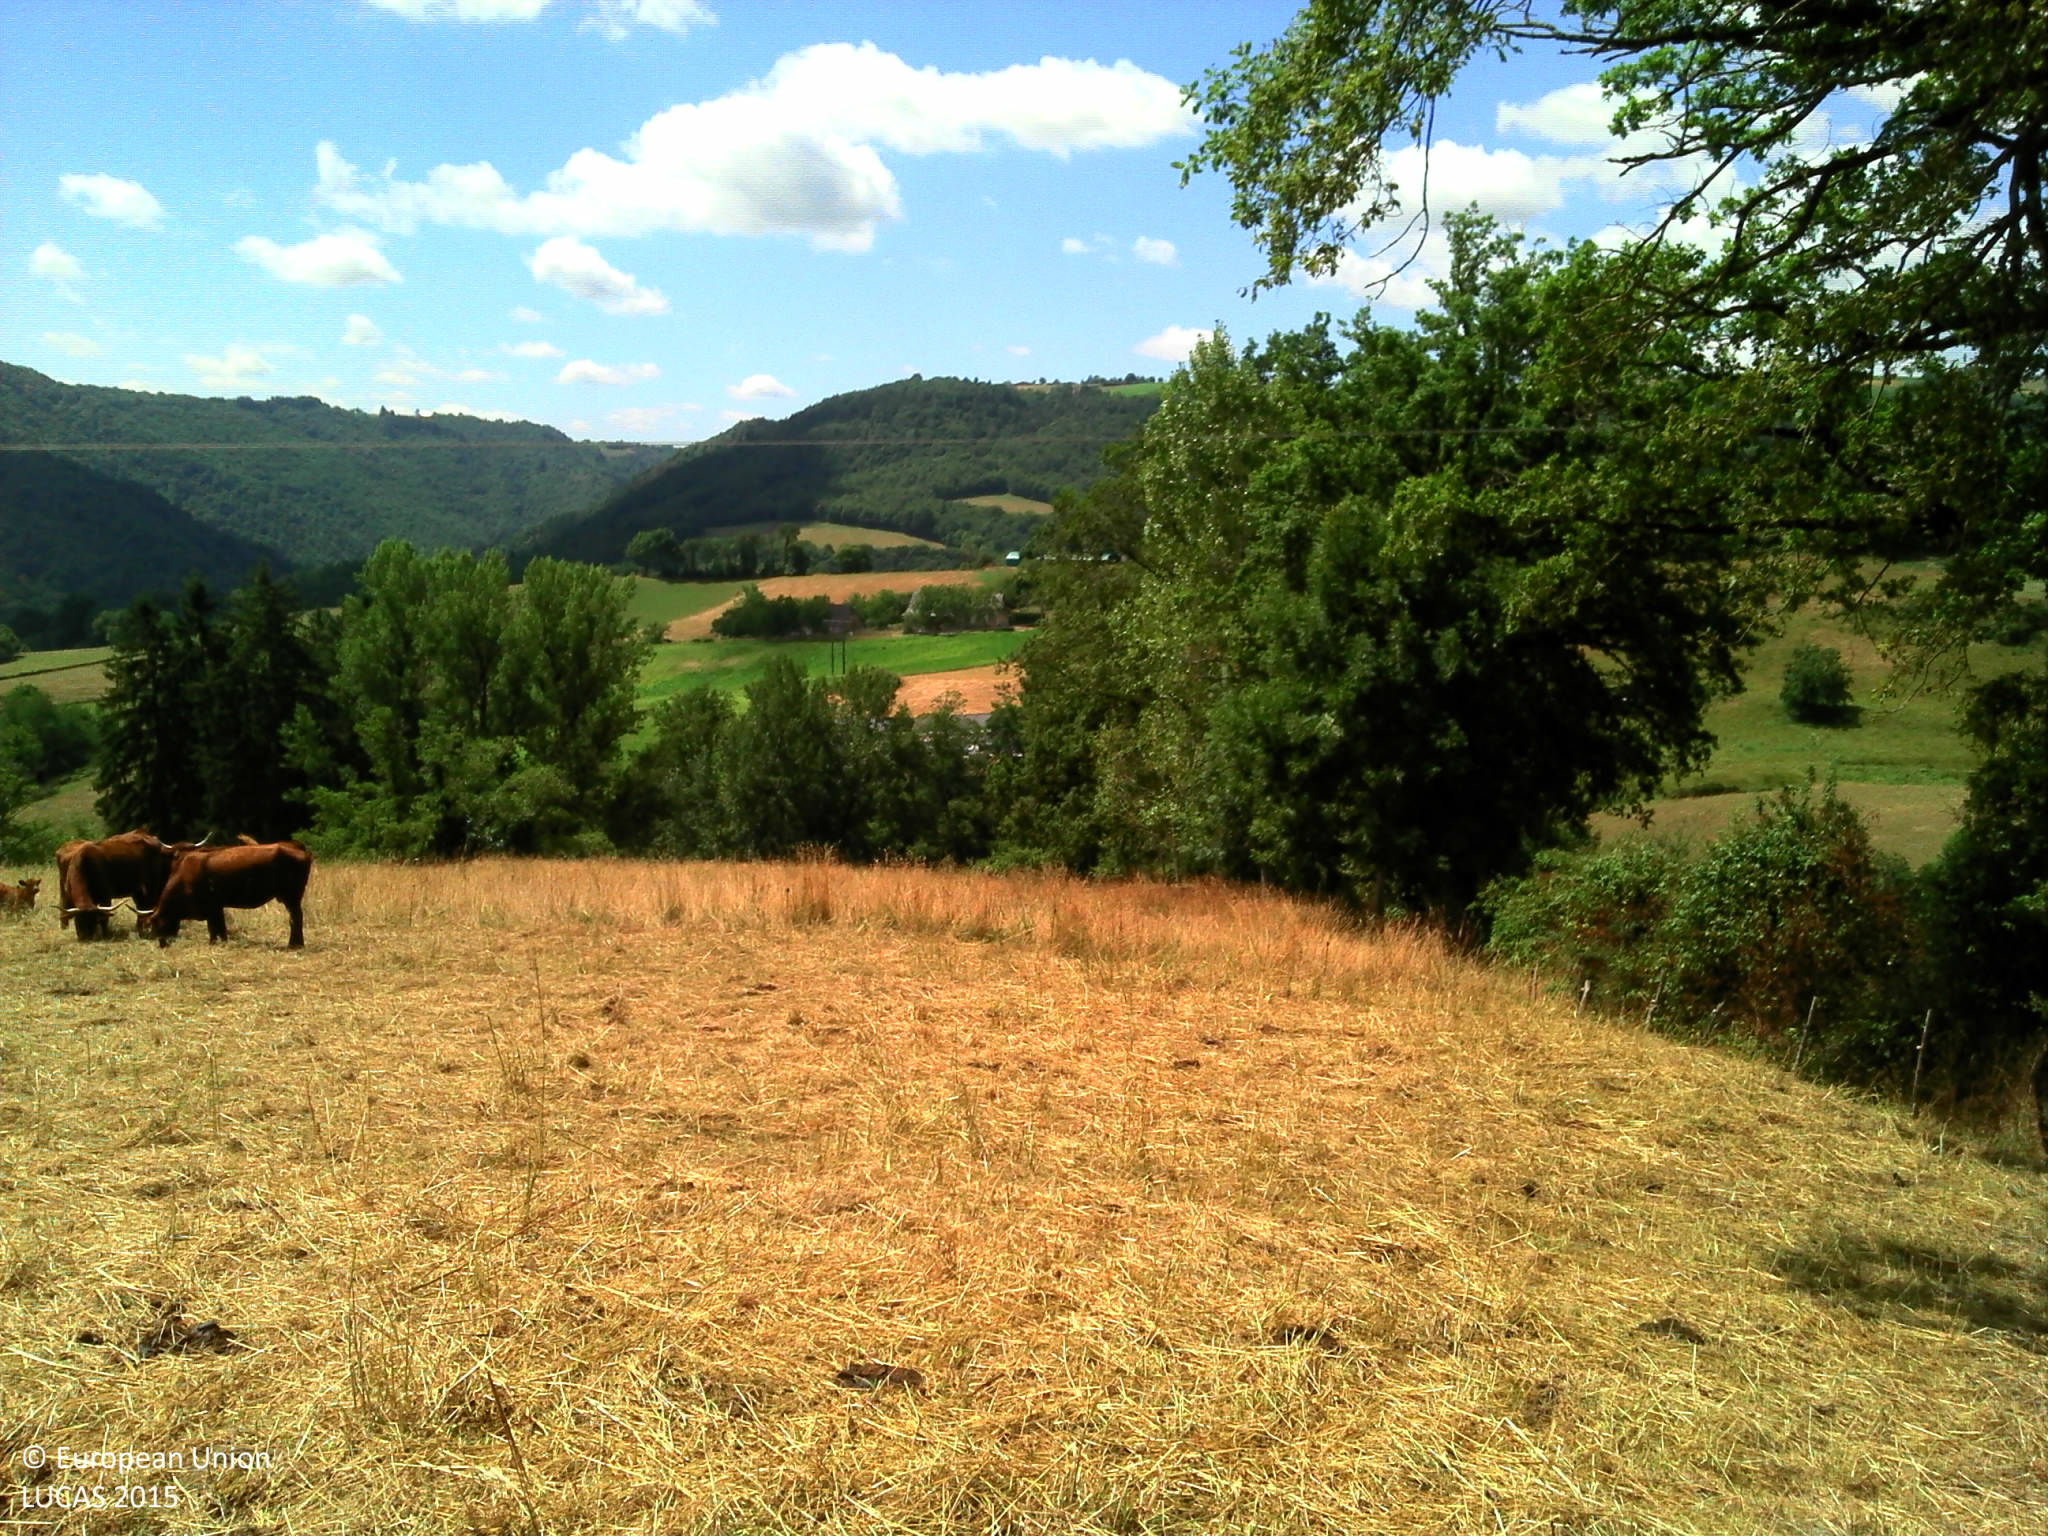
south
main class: Grassland
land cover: Grassland without tree/shrub cover
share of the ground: > 75 %
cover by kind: herbaceous plants 100 %
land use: Agriculture (excluding fallow land and kitchen gardens)
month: July
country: FR
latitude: 44.7065
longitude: 2.4157
